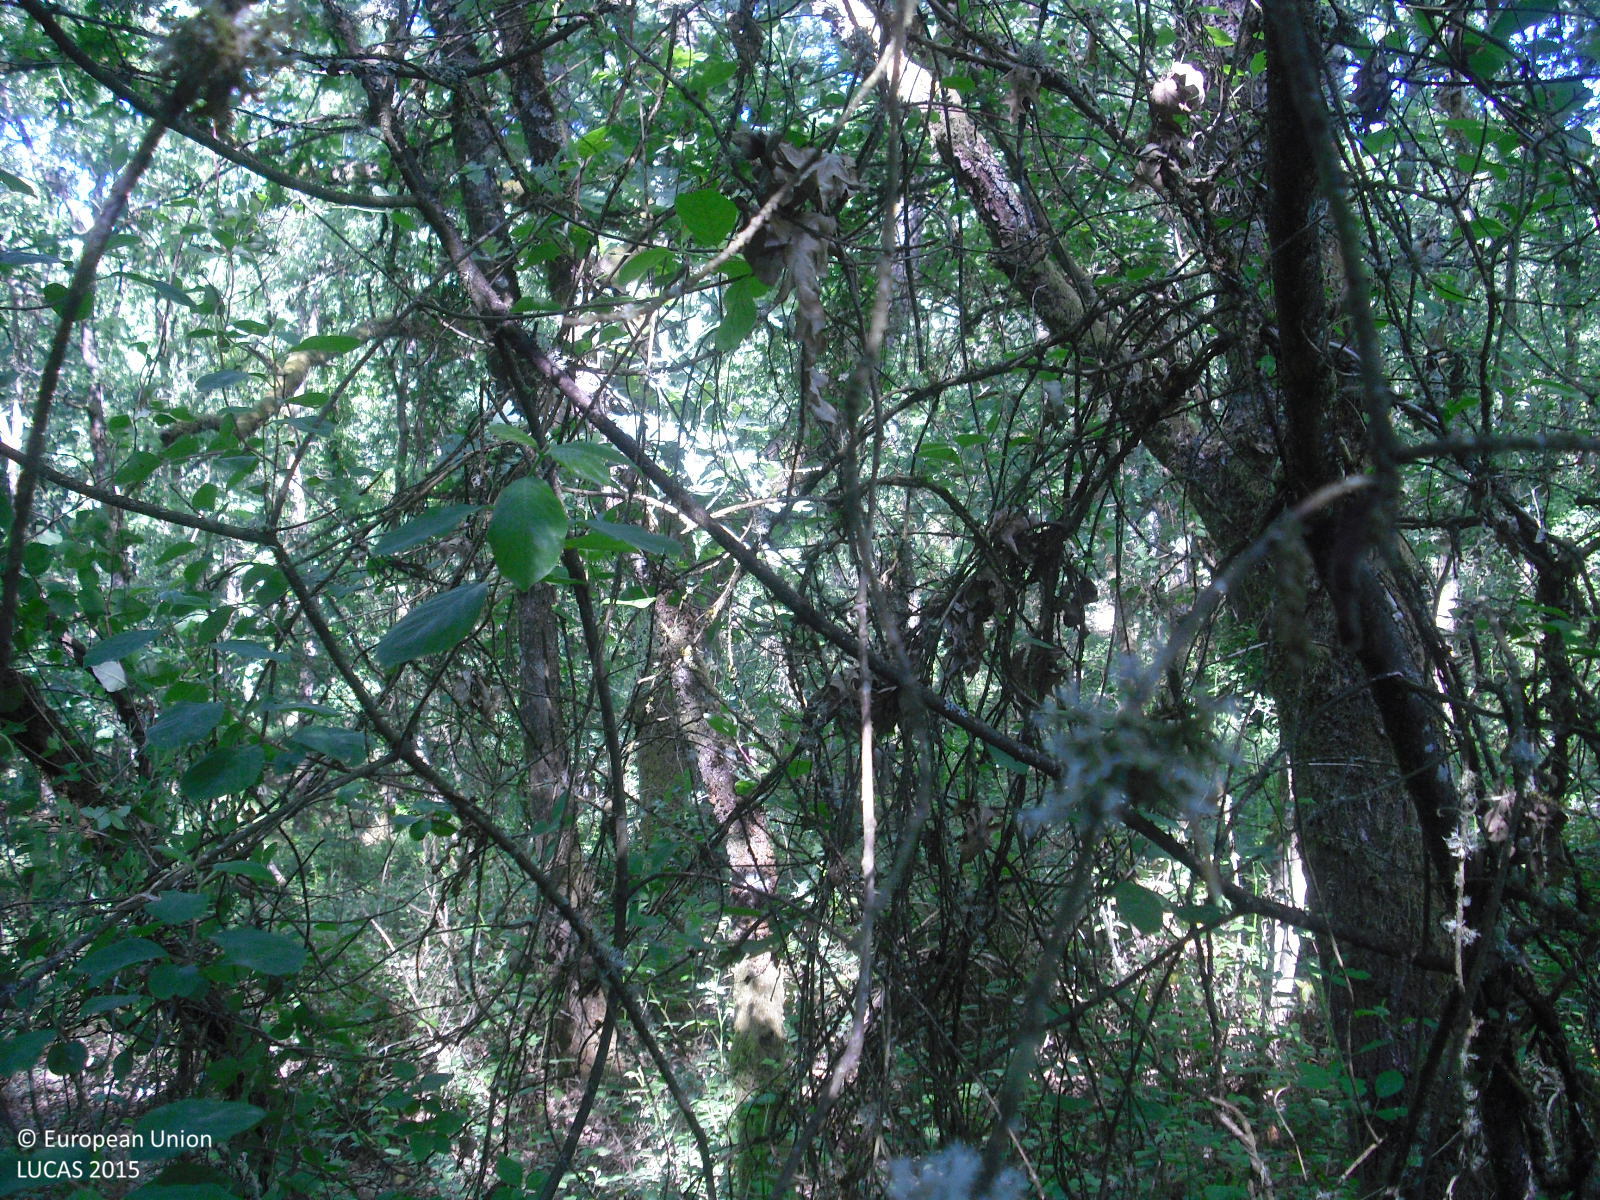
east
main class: Woodland
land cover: Broadleaved woodland
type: thermophilous deciduous forest
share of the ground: > 75 %
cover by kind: broadleaved forest trees 100 %
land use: Forestry
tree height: > 5 m
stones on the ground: < 10 %
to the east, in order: Broadleaved woodland; Tracks; Dry stone walls; Broadleaved woodland; Tracks; Broadleaved woodland; Dry stone walls; Broadleaved woodland; Dry stone walls; Broadleaved woodland; Dry stone walls; Broadleaved woodland
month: May
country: ES
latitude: 42.2634
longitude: -7.6857
